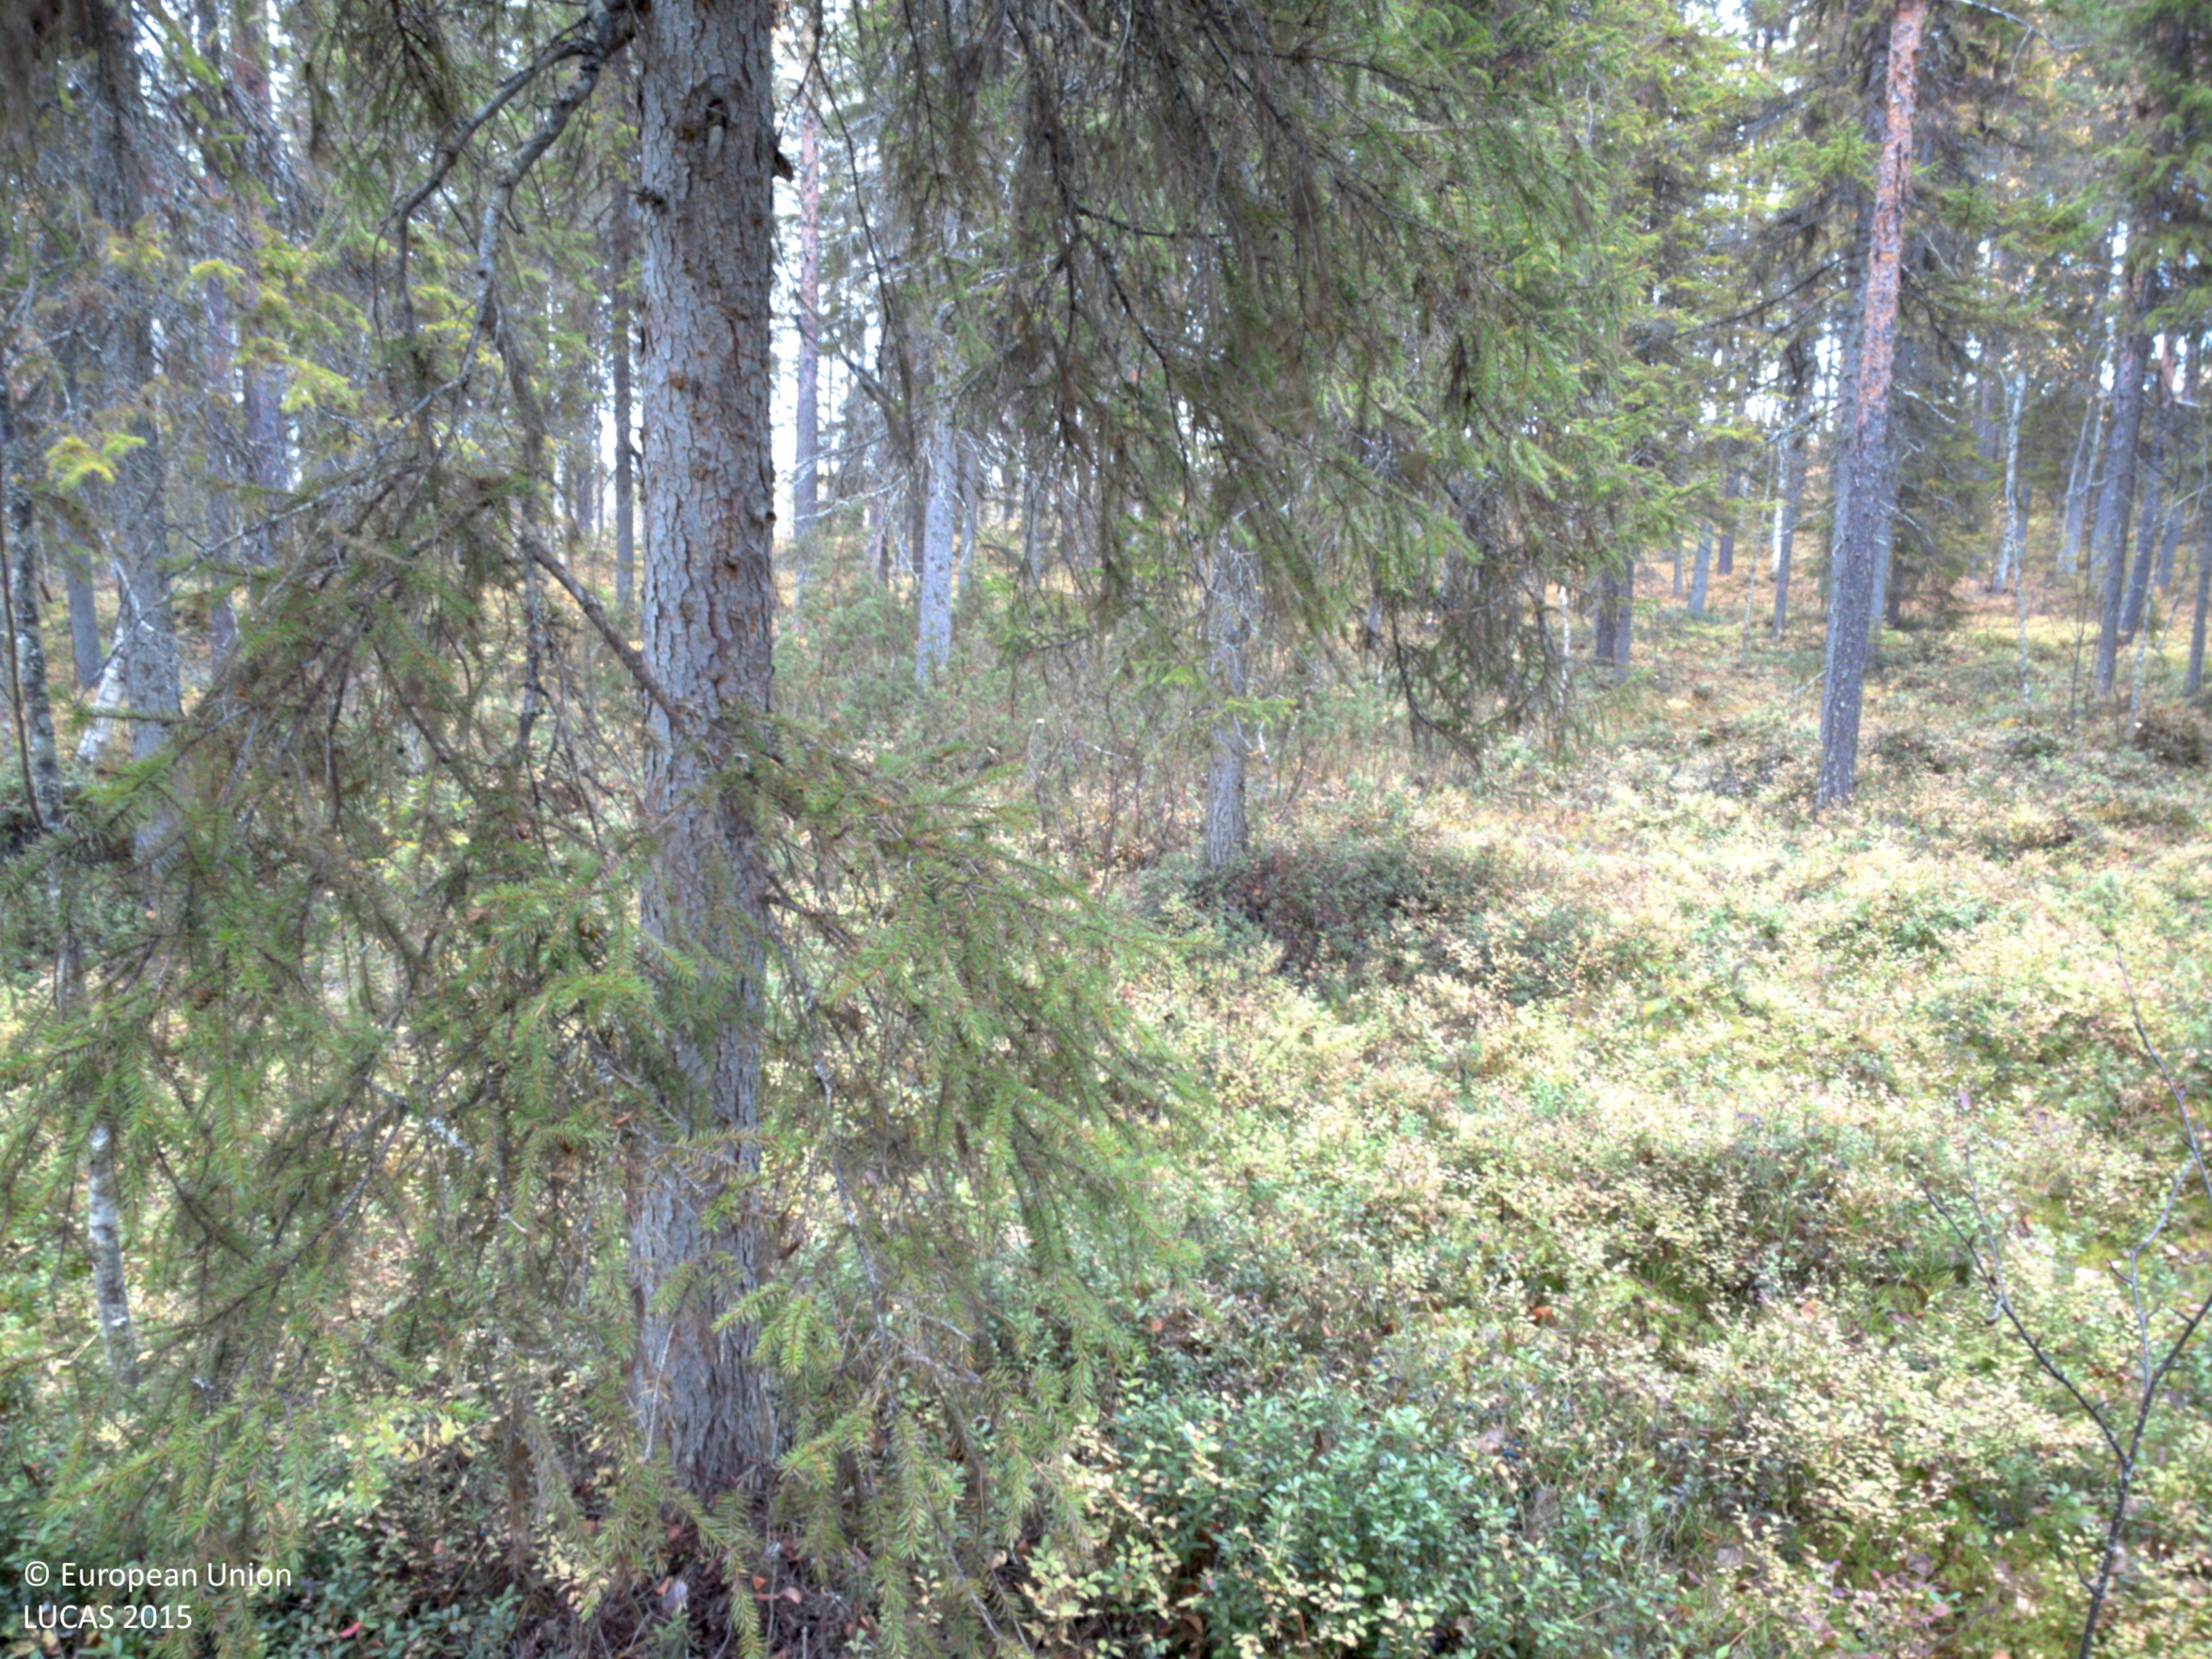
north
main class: Woodland
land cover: Spruce dominated coniferous woodland
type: boreal forest
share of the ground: > 75 %
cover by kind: coniferous forest trees 70 %, shrubs 20 %, broadleaved forest trees 5 %, lichens and mosses 5 %
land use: Forestry
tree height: > 5 m
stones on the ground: < 10 %
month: October
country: SE
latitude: 64.9494
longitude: 18.1981
